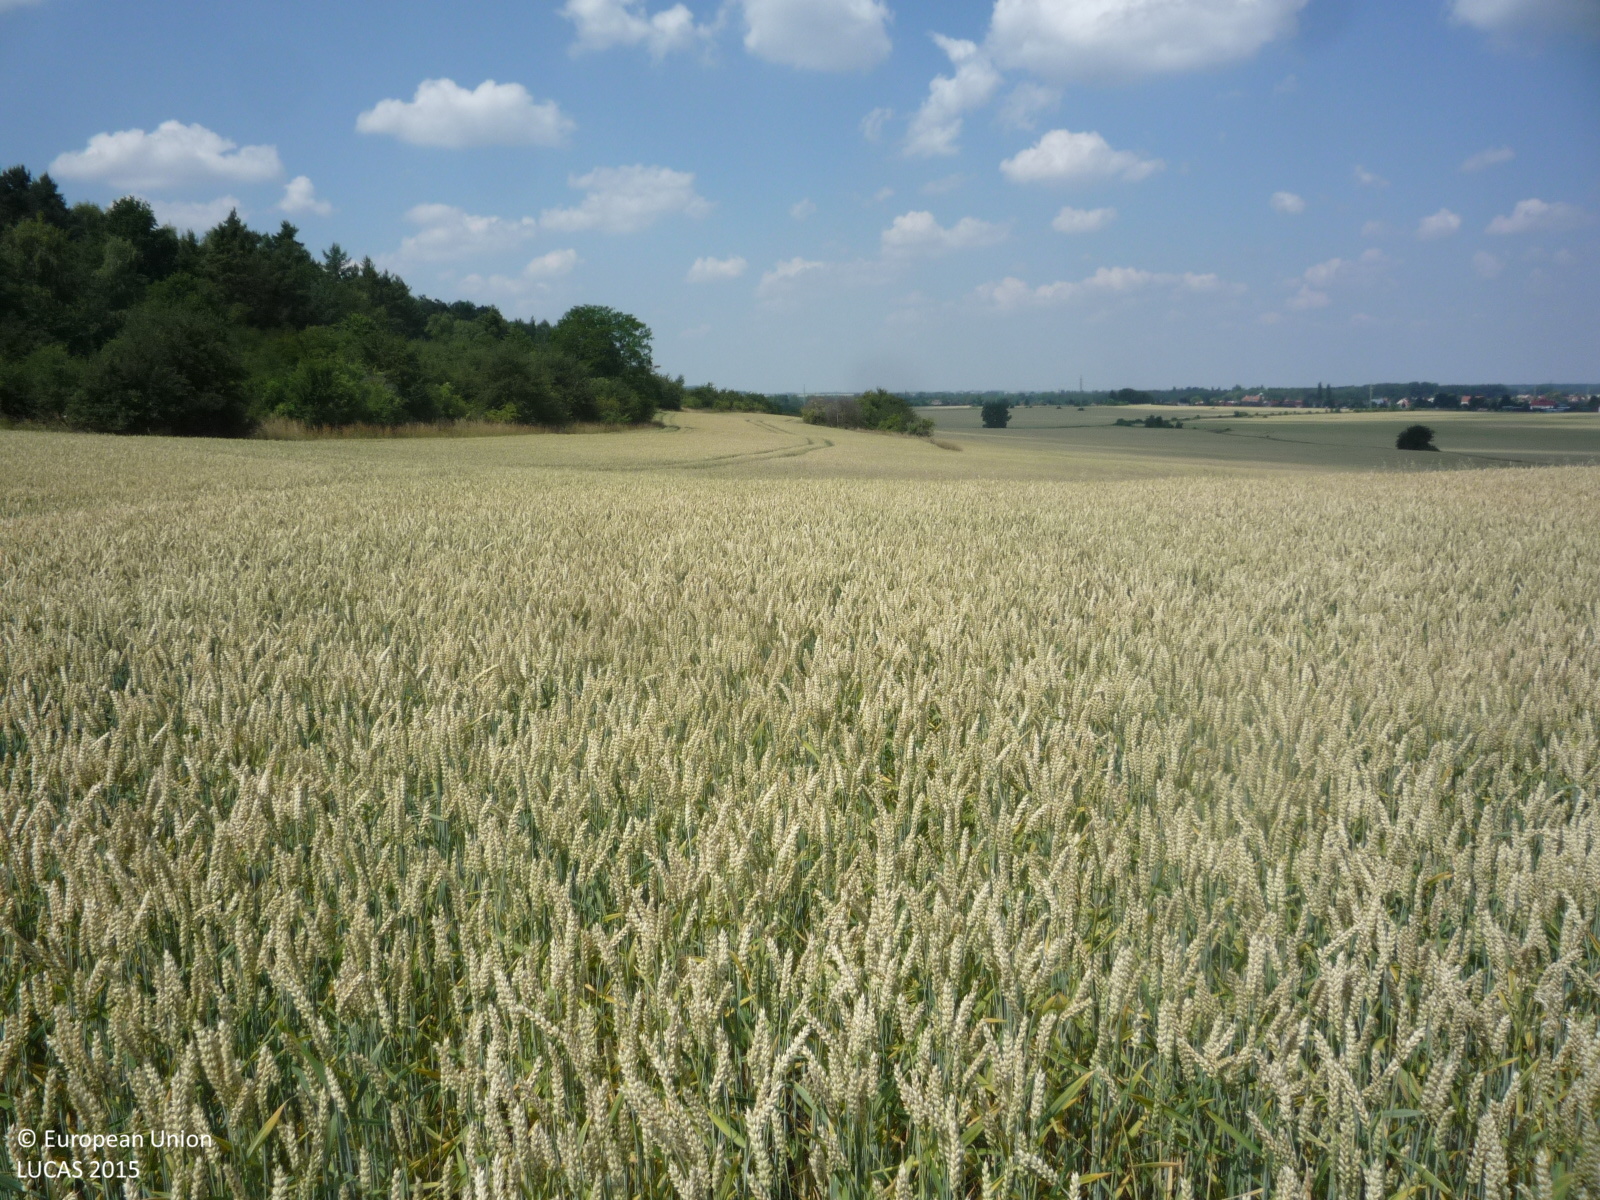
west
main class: Cropland
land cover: Common wheat
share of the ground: > 75 %
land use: Agriculture (excluding fallow land and kitchen gardens)
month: July
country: CZ
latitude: 50.0458
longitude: 15.2400
